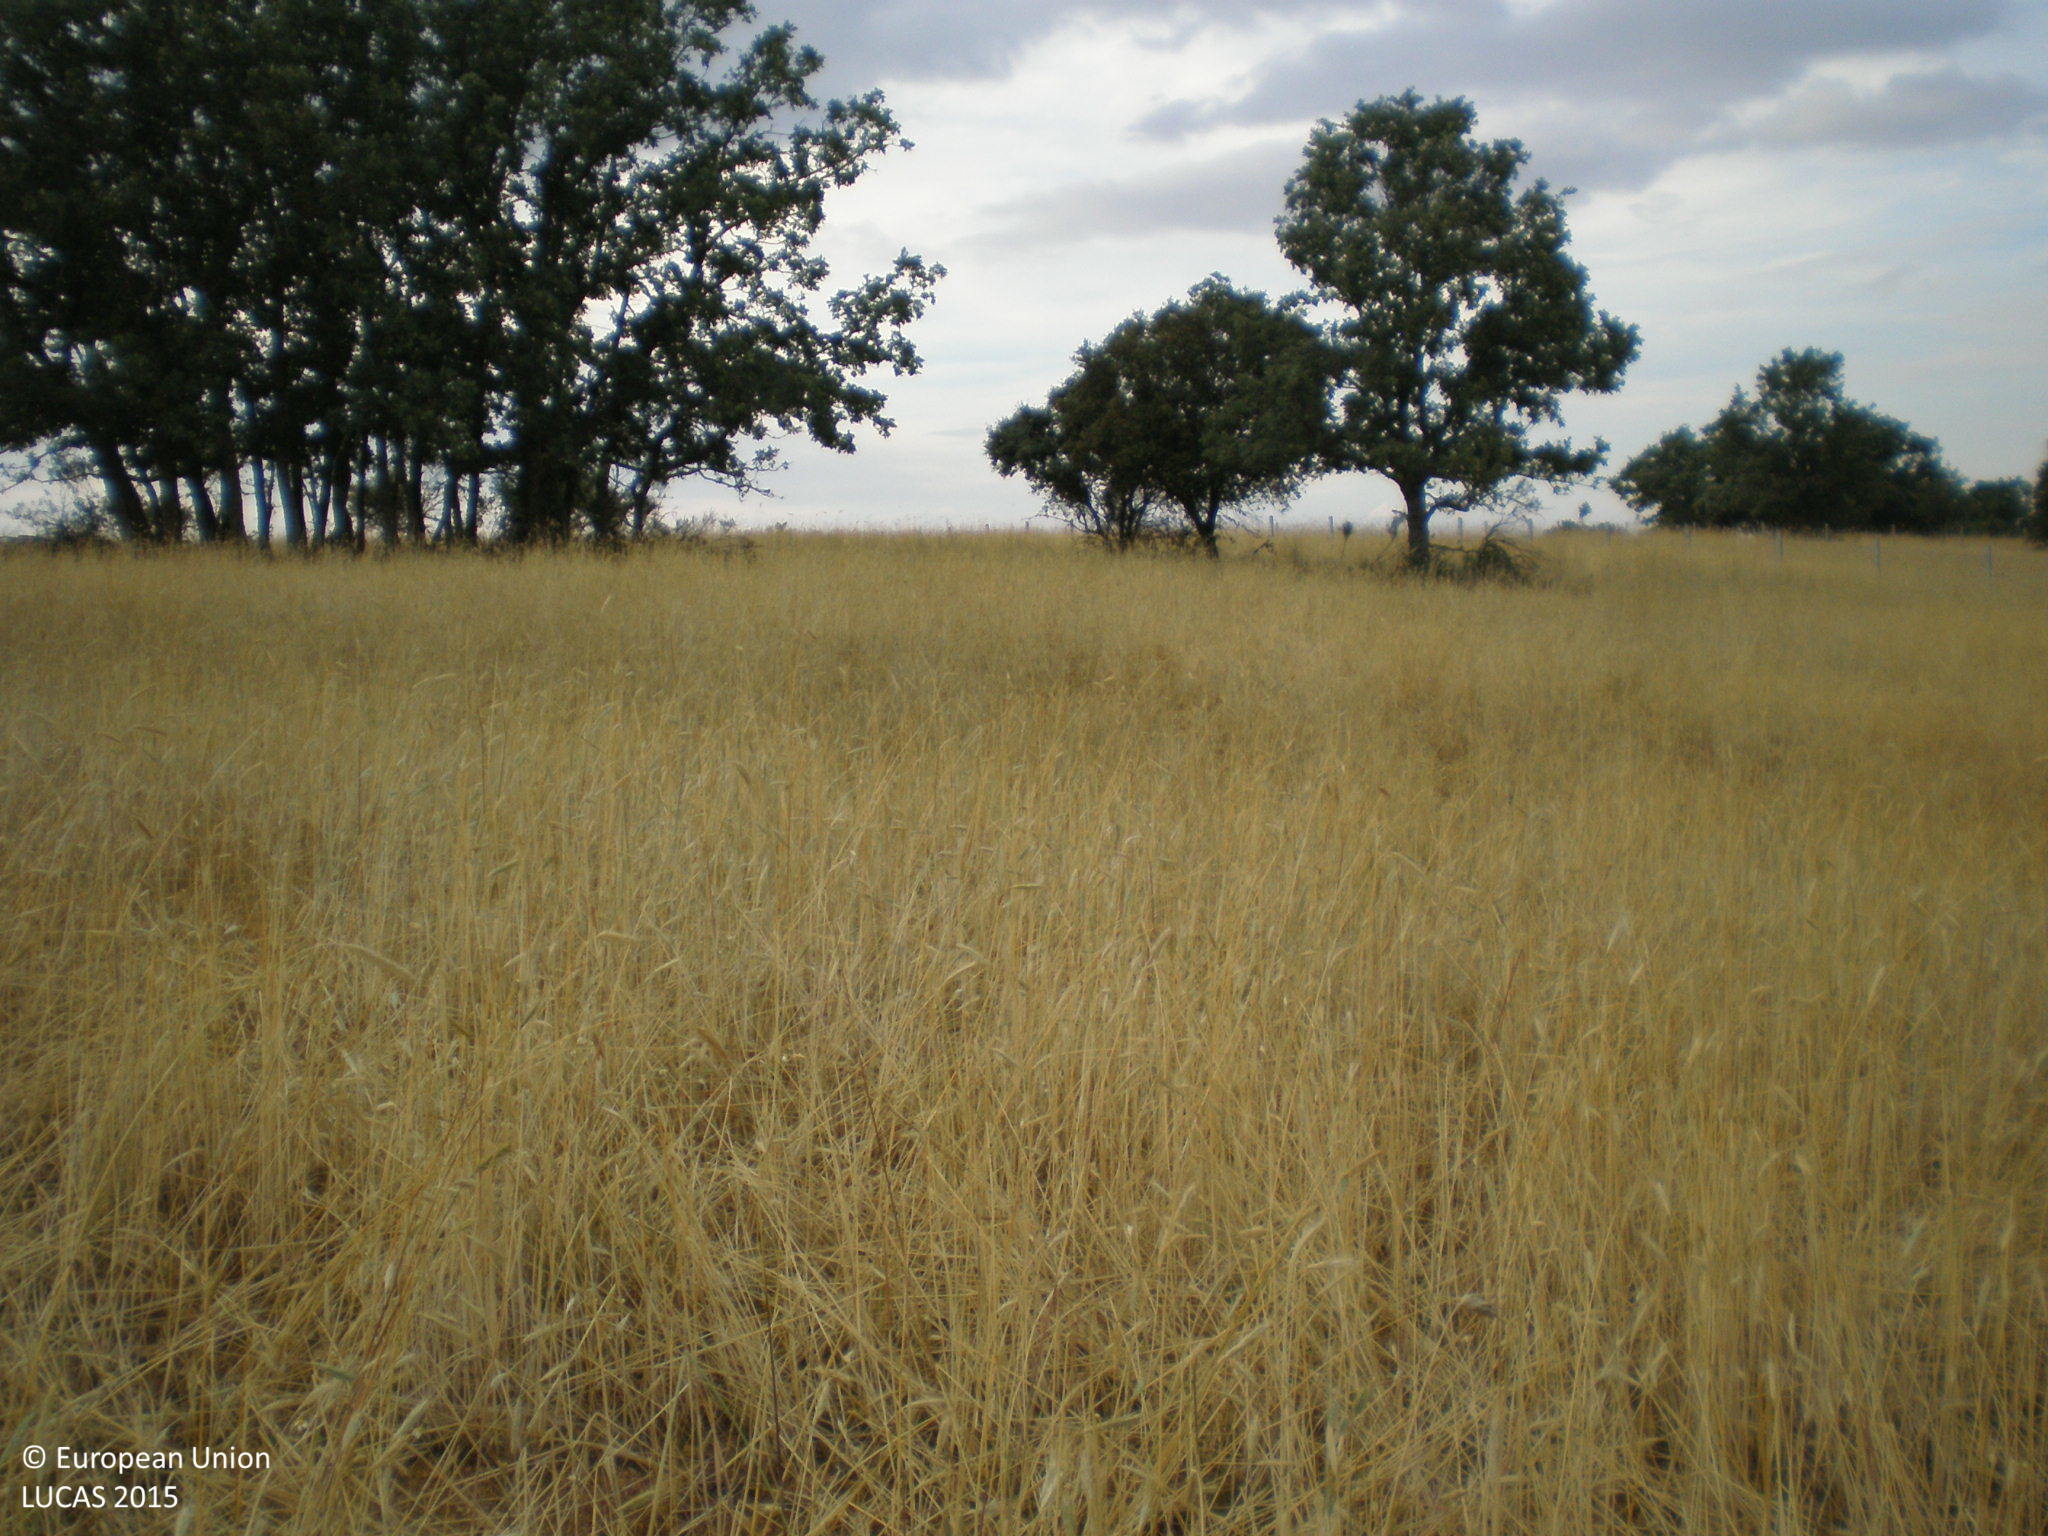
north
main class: Cropland
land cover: Rye
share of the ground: > 75 %
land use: Agriculture (excluding fallow land and kitchen gardens)
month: June
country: ES
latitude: 41.2221
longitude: -5.7935
